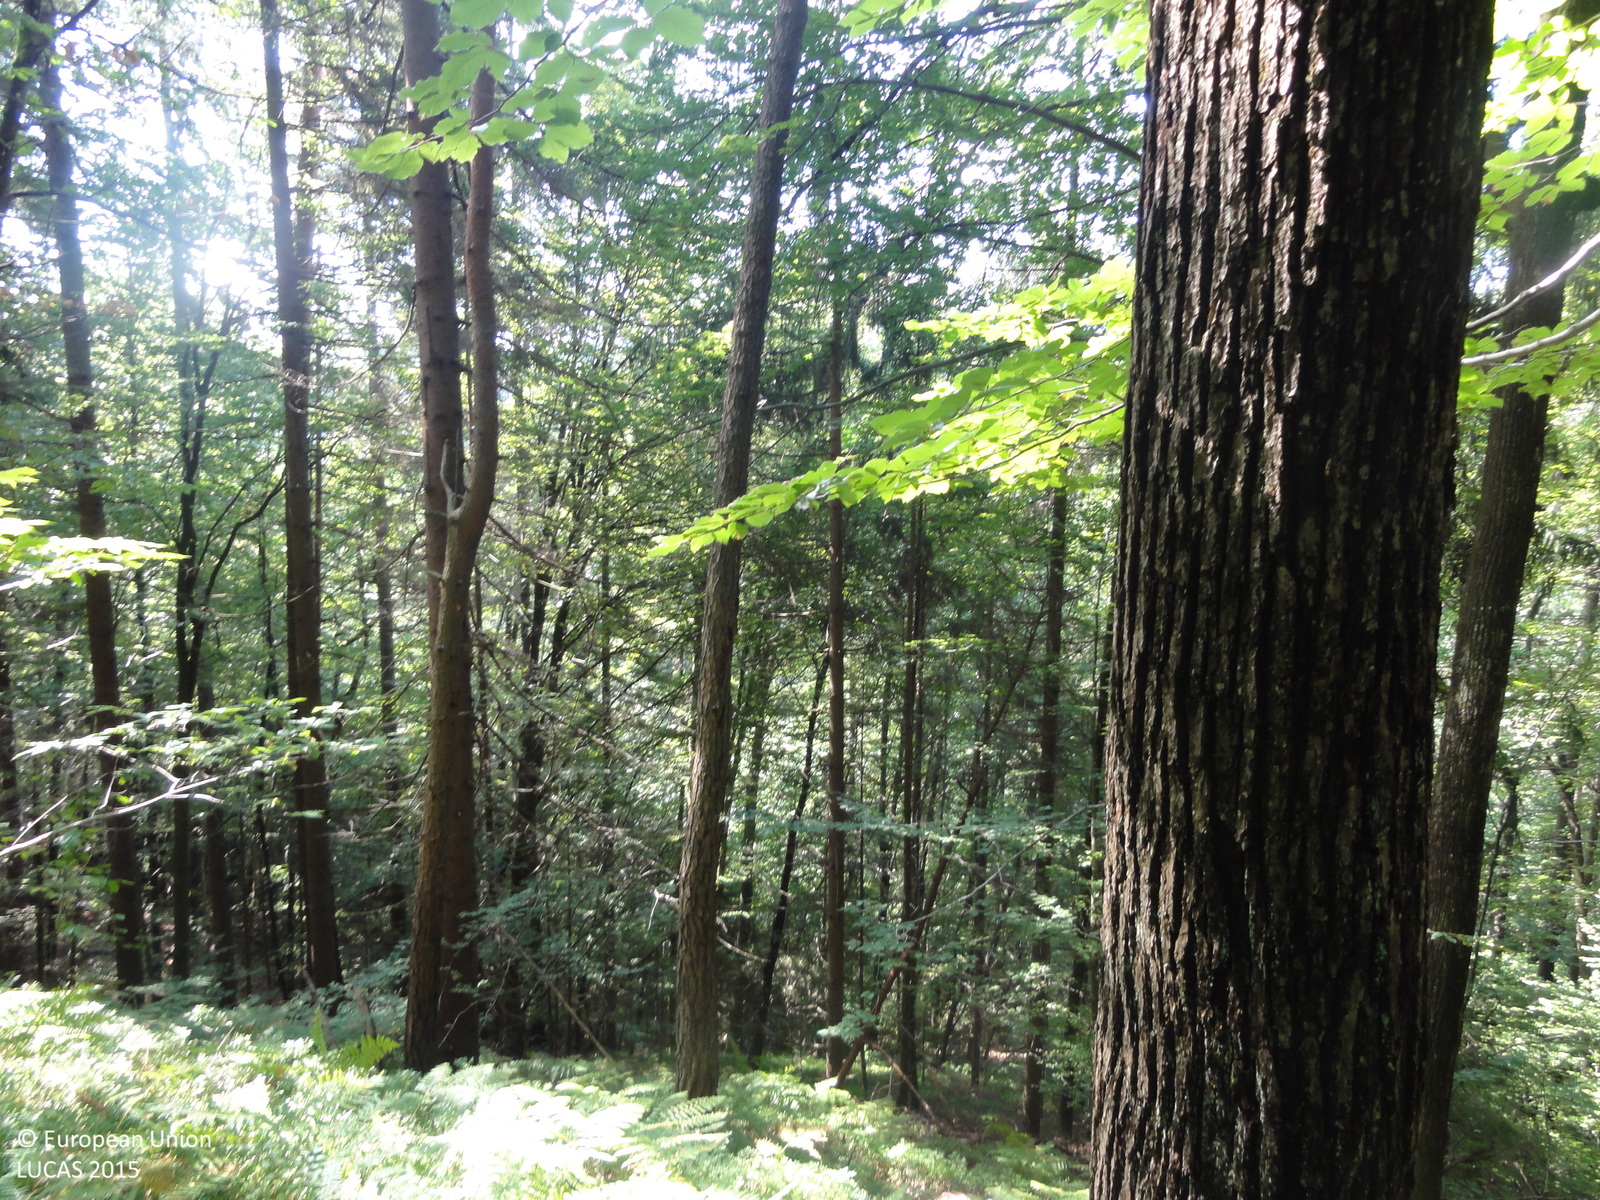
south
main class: Woodland
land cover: Other mixed woodland
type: mountainous beech forest
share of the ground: > 75 %
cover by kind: broadleaved forest trees 60 %, coniferous forest trees 35 %, herbaceous plants 5 %
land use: Forestry
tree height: > 5 m
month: August
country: SI
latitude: 46.0454
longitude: 14.7911
